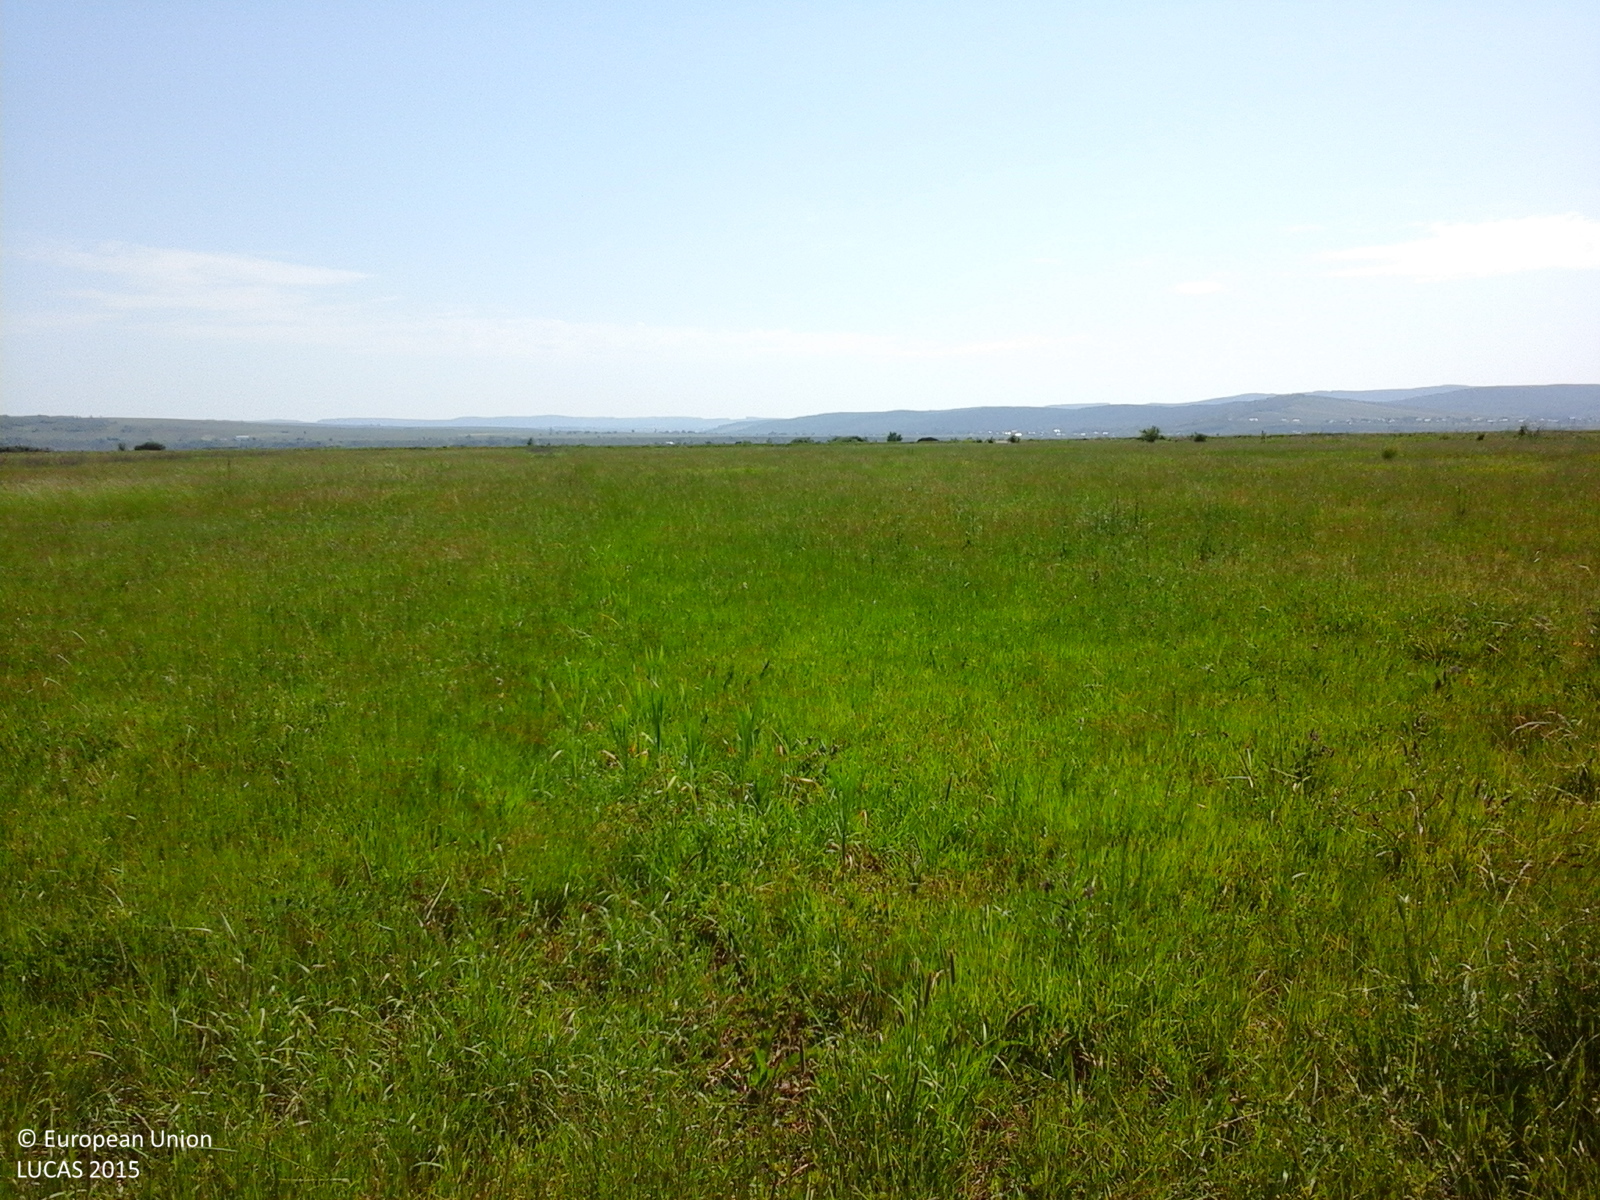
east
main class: Grassland
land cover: Grassland without tree/shrub cover
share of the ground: > 75 %
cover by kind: herbaceous plants 100 %
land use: Agriculture (excluding fallow land and kitchen gardens)
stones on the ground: < 10 %
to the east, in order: Grassland without tree/shrub cover
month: June
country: RO
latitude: 46.6215
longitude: 26.9551
